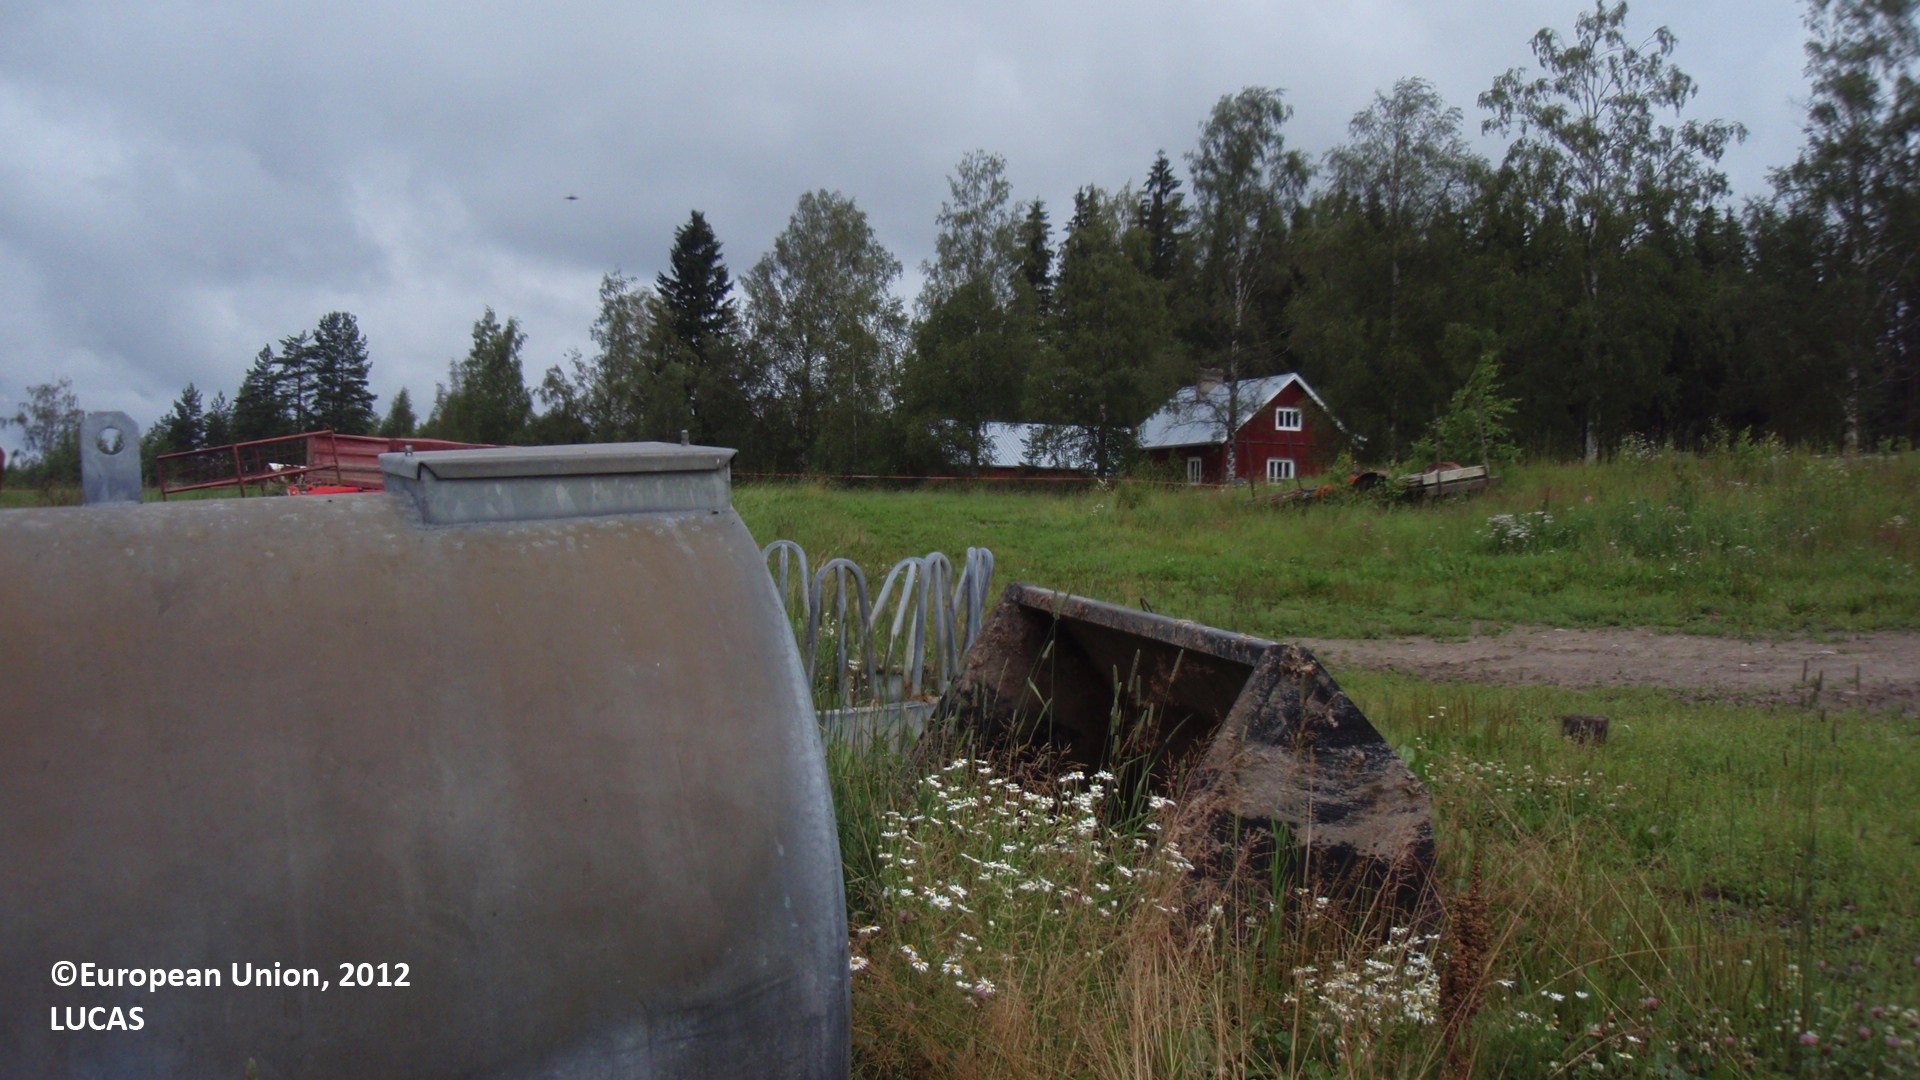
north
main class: Grassland
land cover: Grassland without tree/shrub cover
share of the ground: > 75 %
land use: Agriculture (excluding fallow land and kitchen gardens)
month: July
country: FI
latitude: 61.5329
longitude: 27.3815
